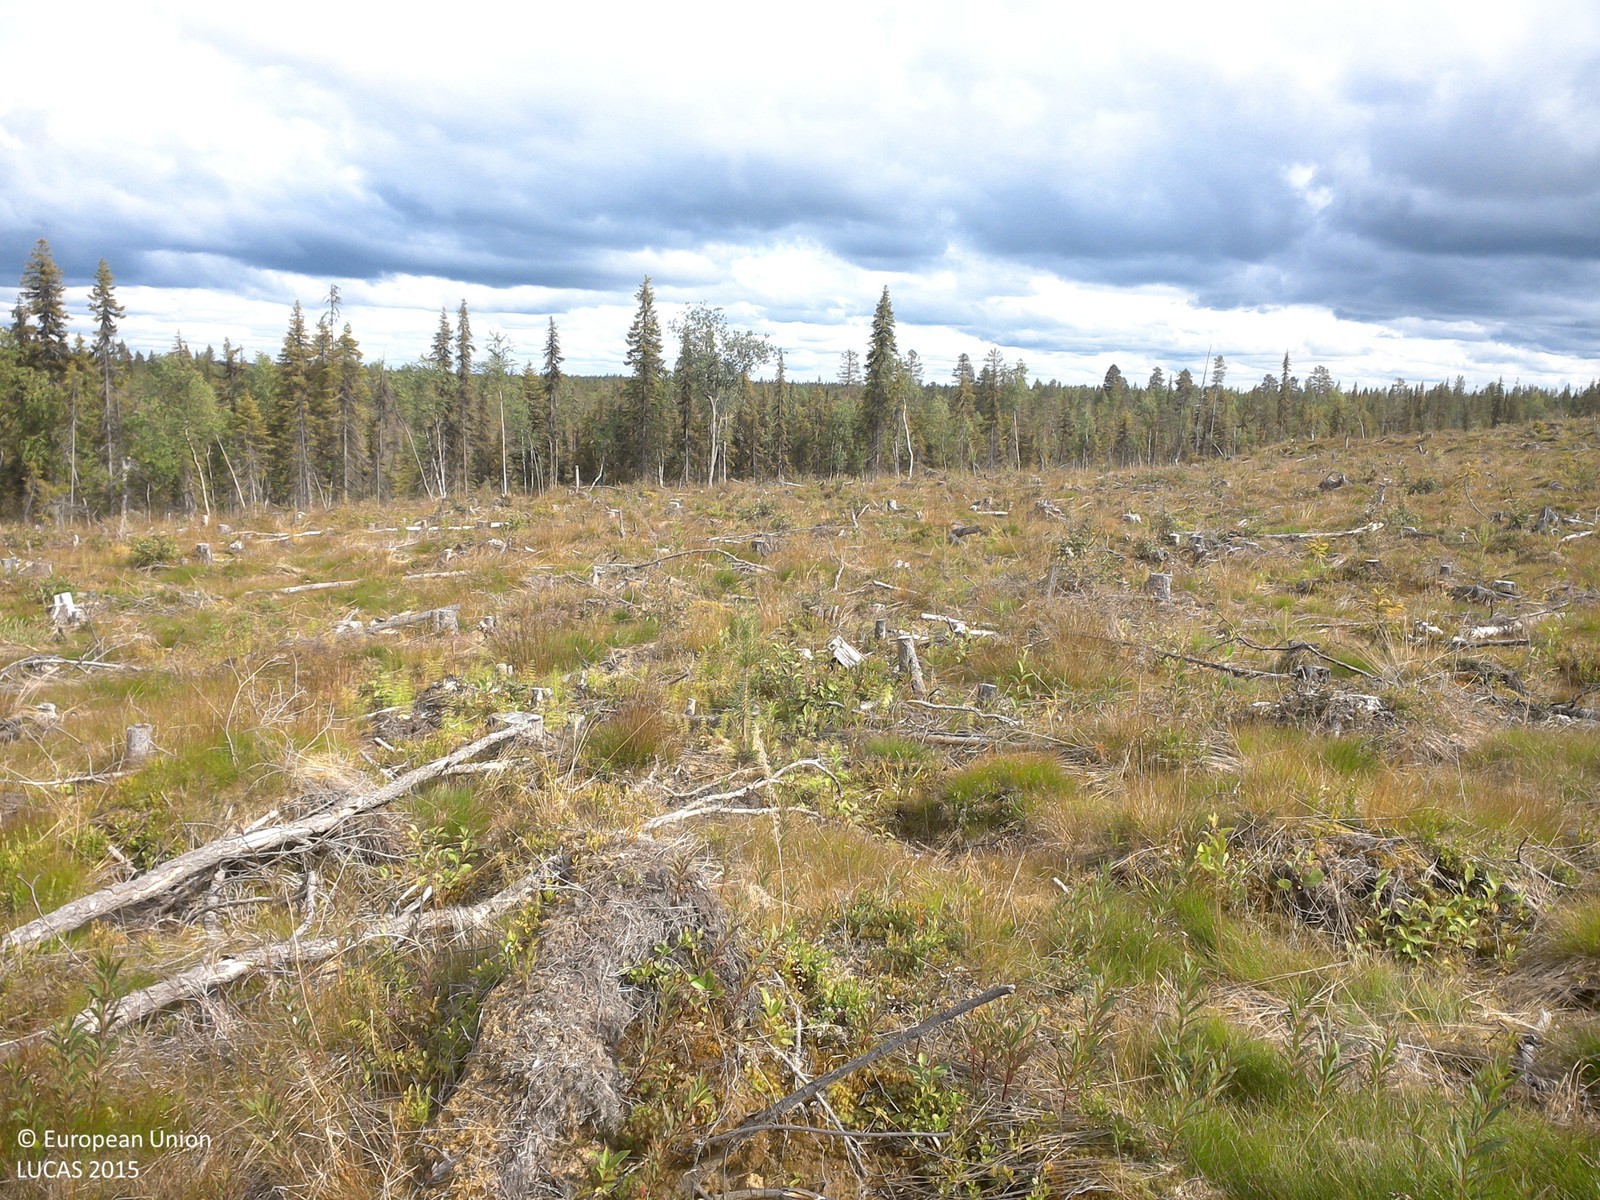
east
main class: Shrubland
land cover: Shrubland with sparse tree cover
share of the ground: 10 - 25 %
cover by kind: herbaceous plants 75 %, shrubs 10 %, unconsolidated bare surface 10 %, broadleaved forest trees 5 %
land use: Forestry
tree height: < 5 m
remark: Clear cut
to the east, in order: Shrubland with sparse tree cover; Spruce dominated coniferous woodland; Pine dominated coniferous woodland
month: July
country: SE
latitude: 67.5009
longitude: 22.2495
